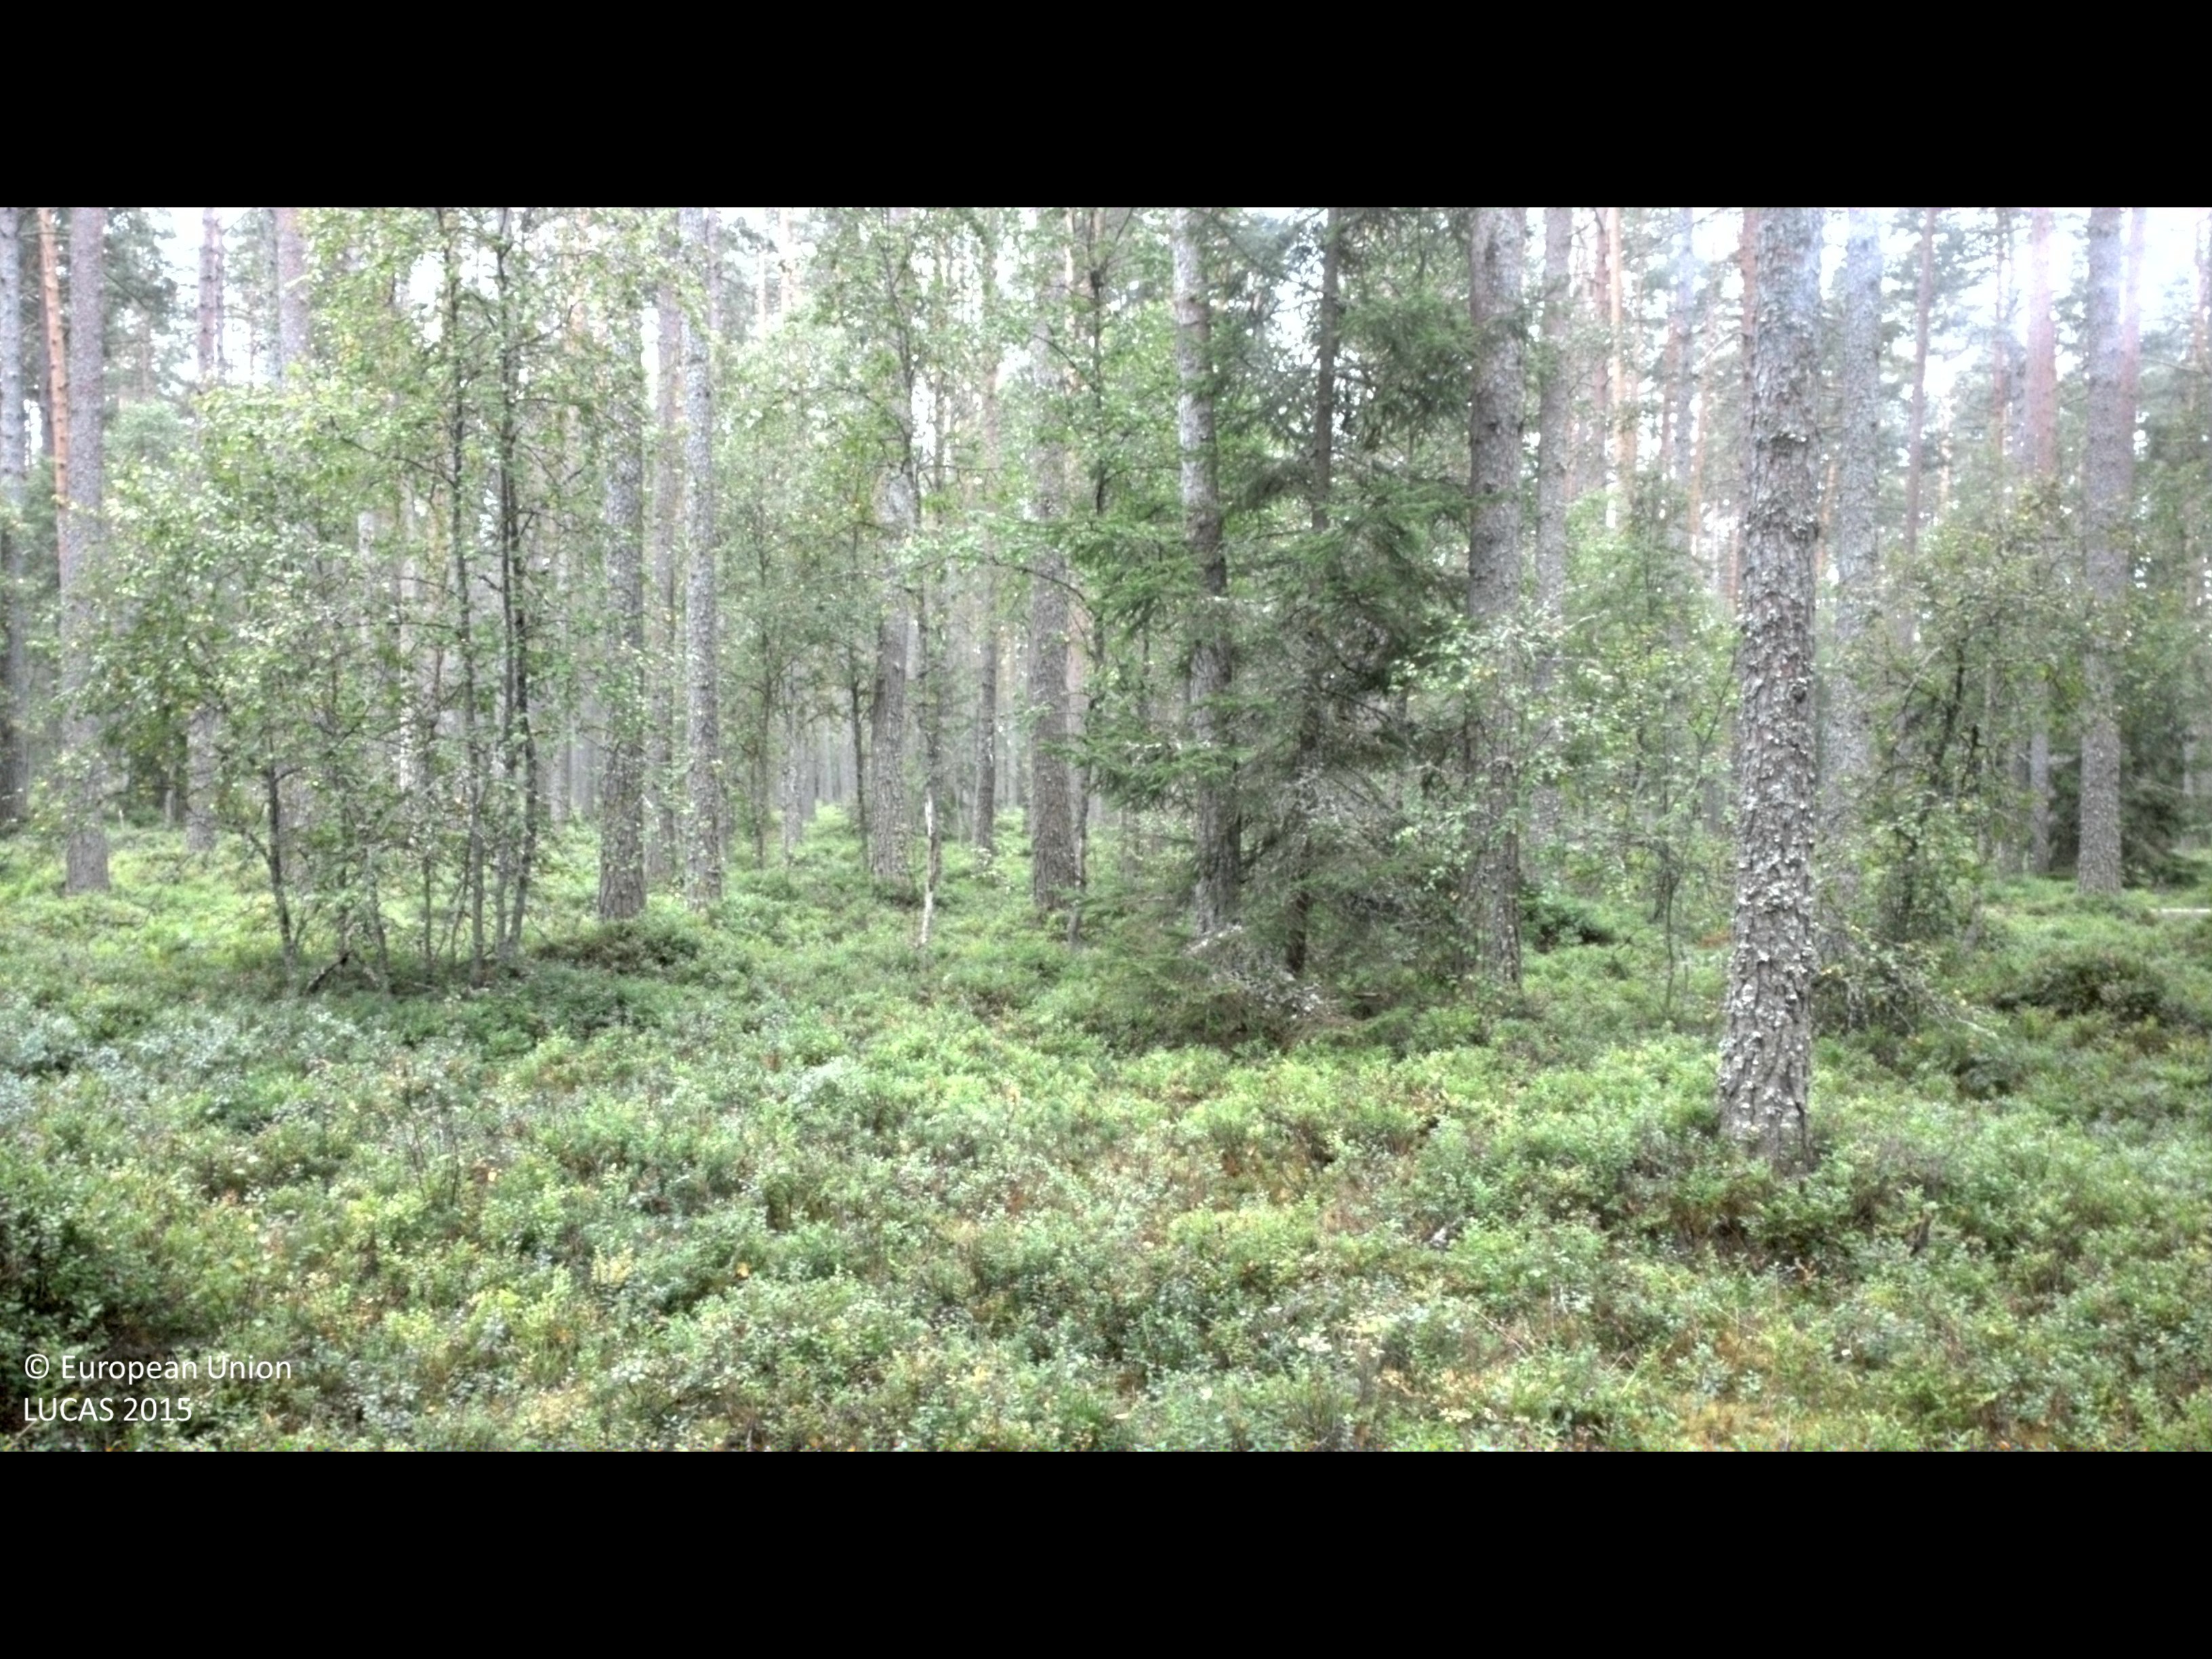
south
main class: Woodland
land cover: Spruce dominated coniferous woodland
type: boreal forest
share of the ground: 50 - 75 %
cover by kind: coniferous forest trees 60 %, shrubs 30 %, broadleaved forest trees 10 %
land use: Forestry
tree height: > 5 m
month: August
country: SE
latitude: 57.3347
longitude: 13.8996
